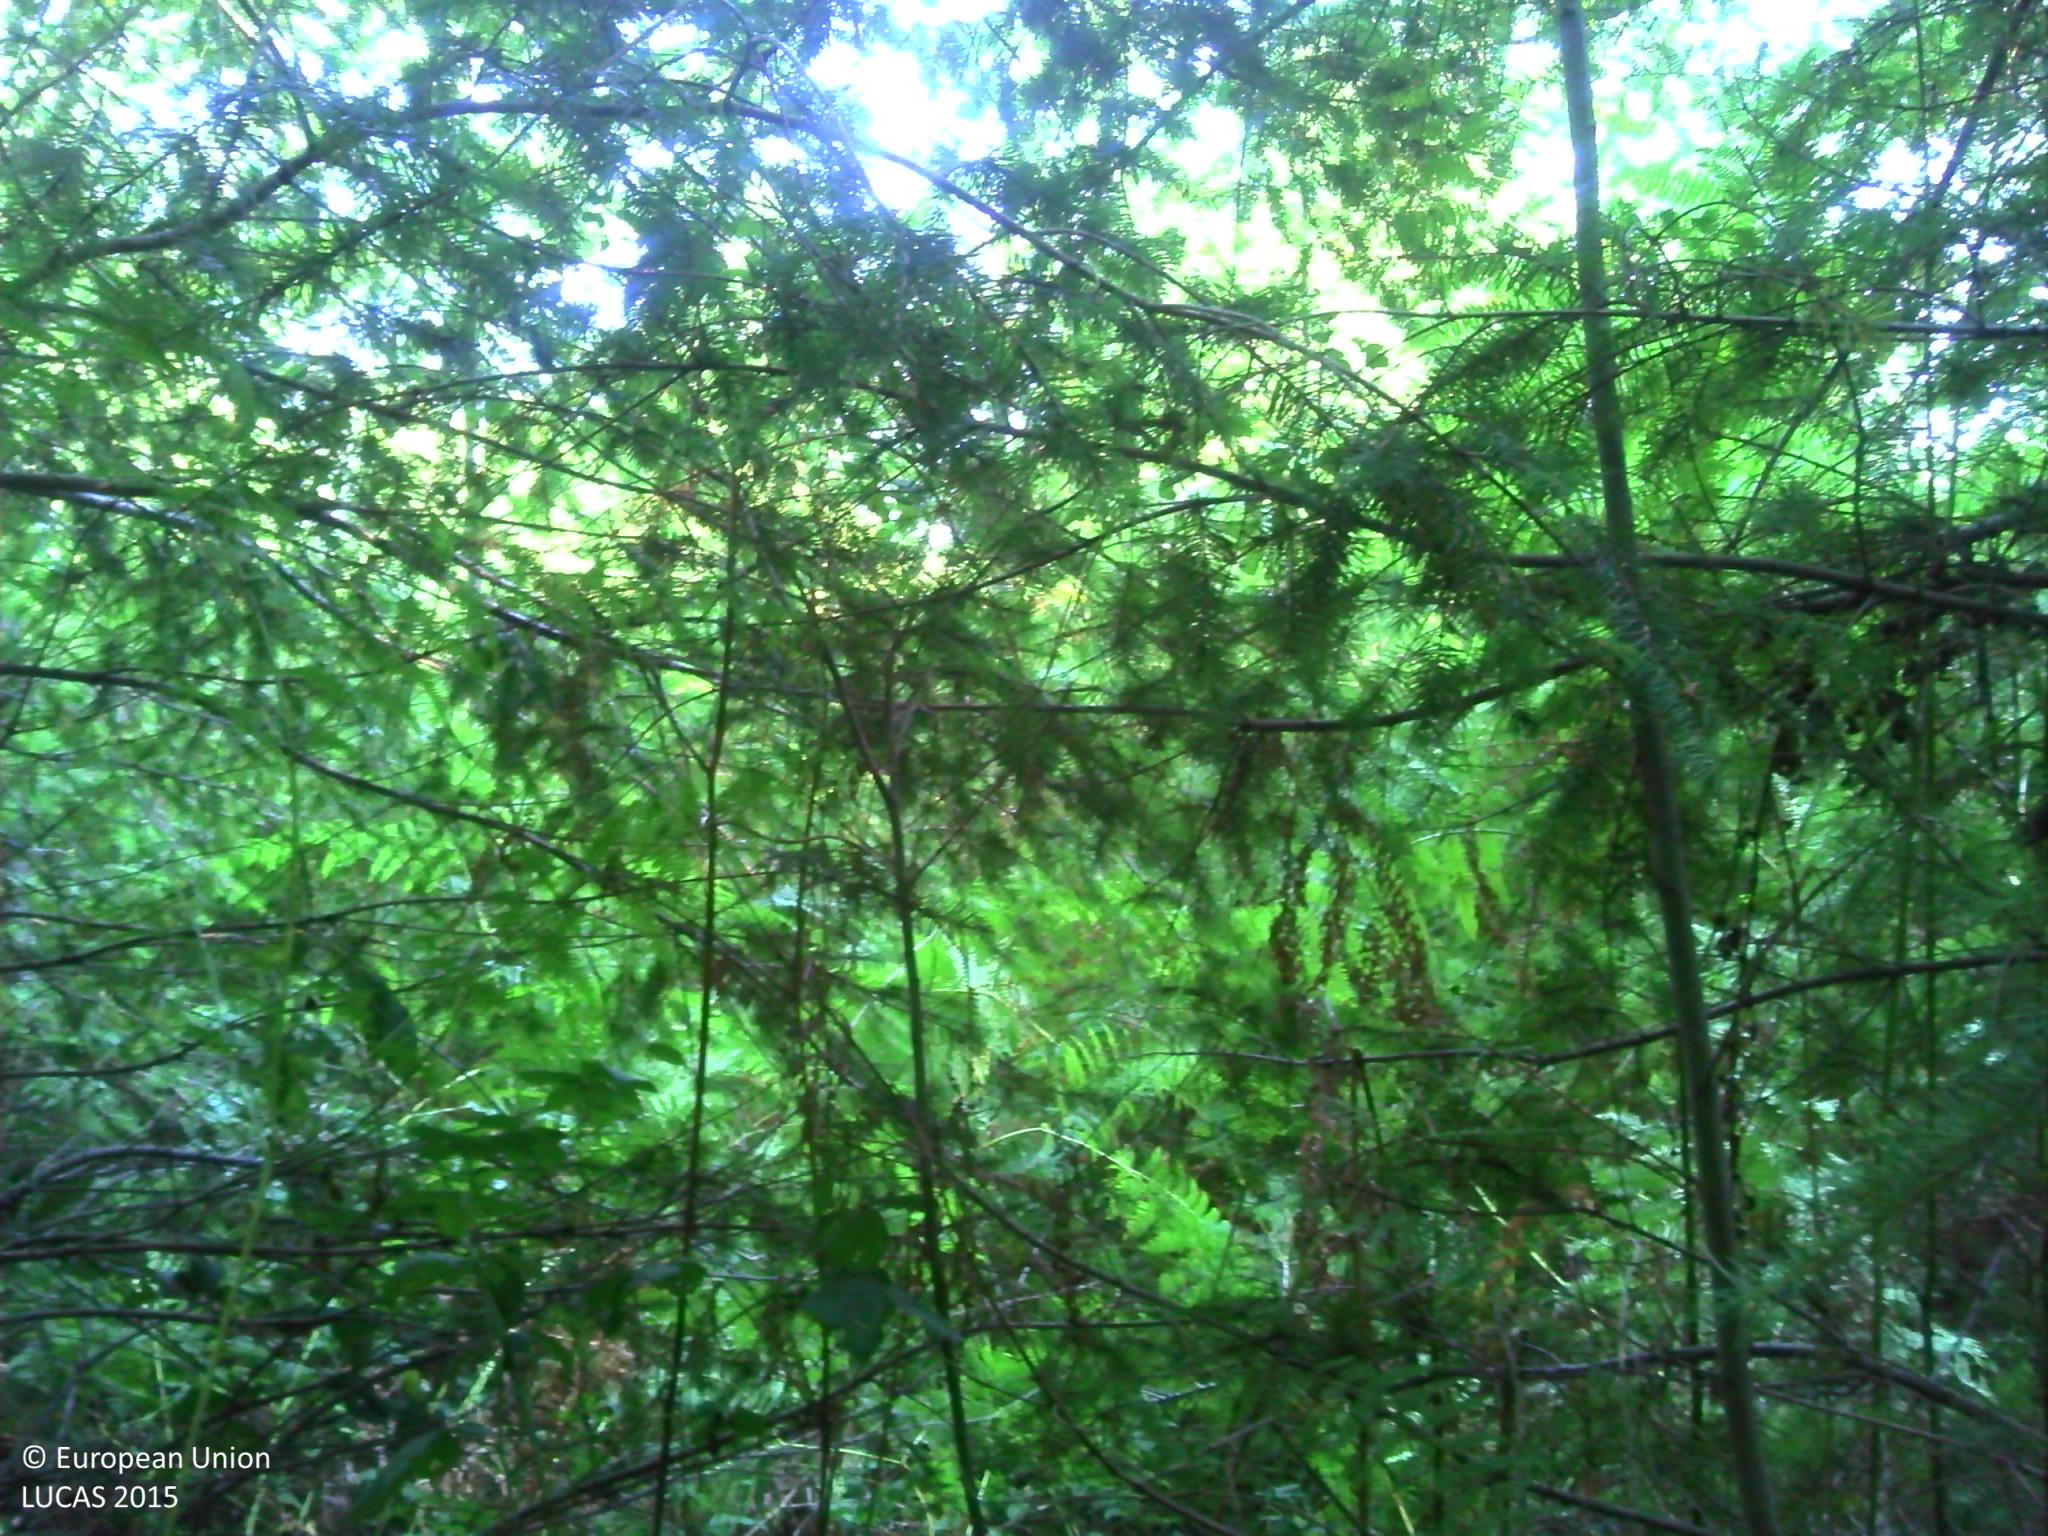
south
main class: Woodland
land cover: Other coniferous woodland
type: exotic forest
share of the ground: > 75 %
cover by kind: coniferous forest trees 70 %, herbaceous plants 15 %, broadleaved forest trees 5 %, shrubs 5 %, lichens and mosses 5 %
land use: Forestry
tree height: > 5 m
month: August
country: FR
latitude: 45.8860
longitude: 1.7335
